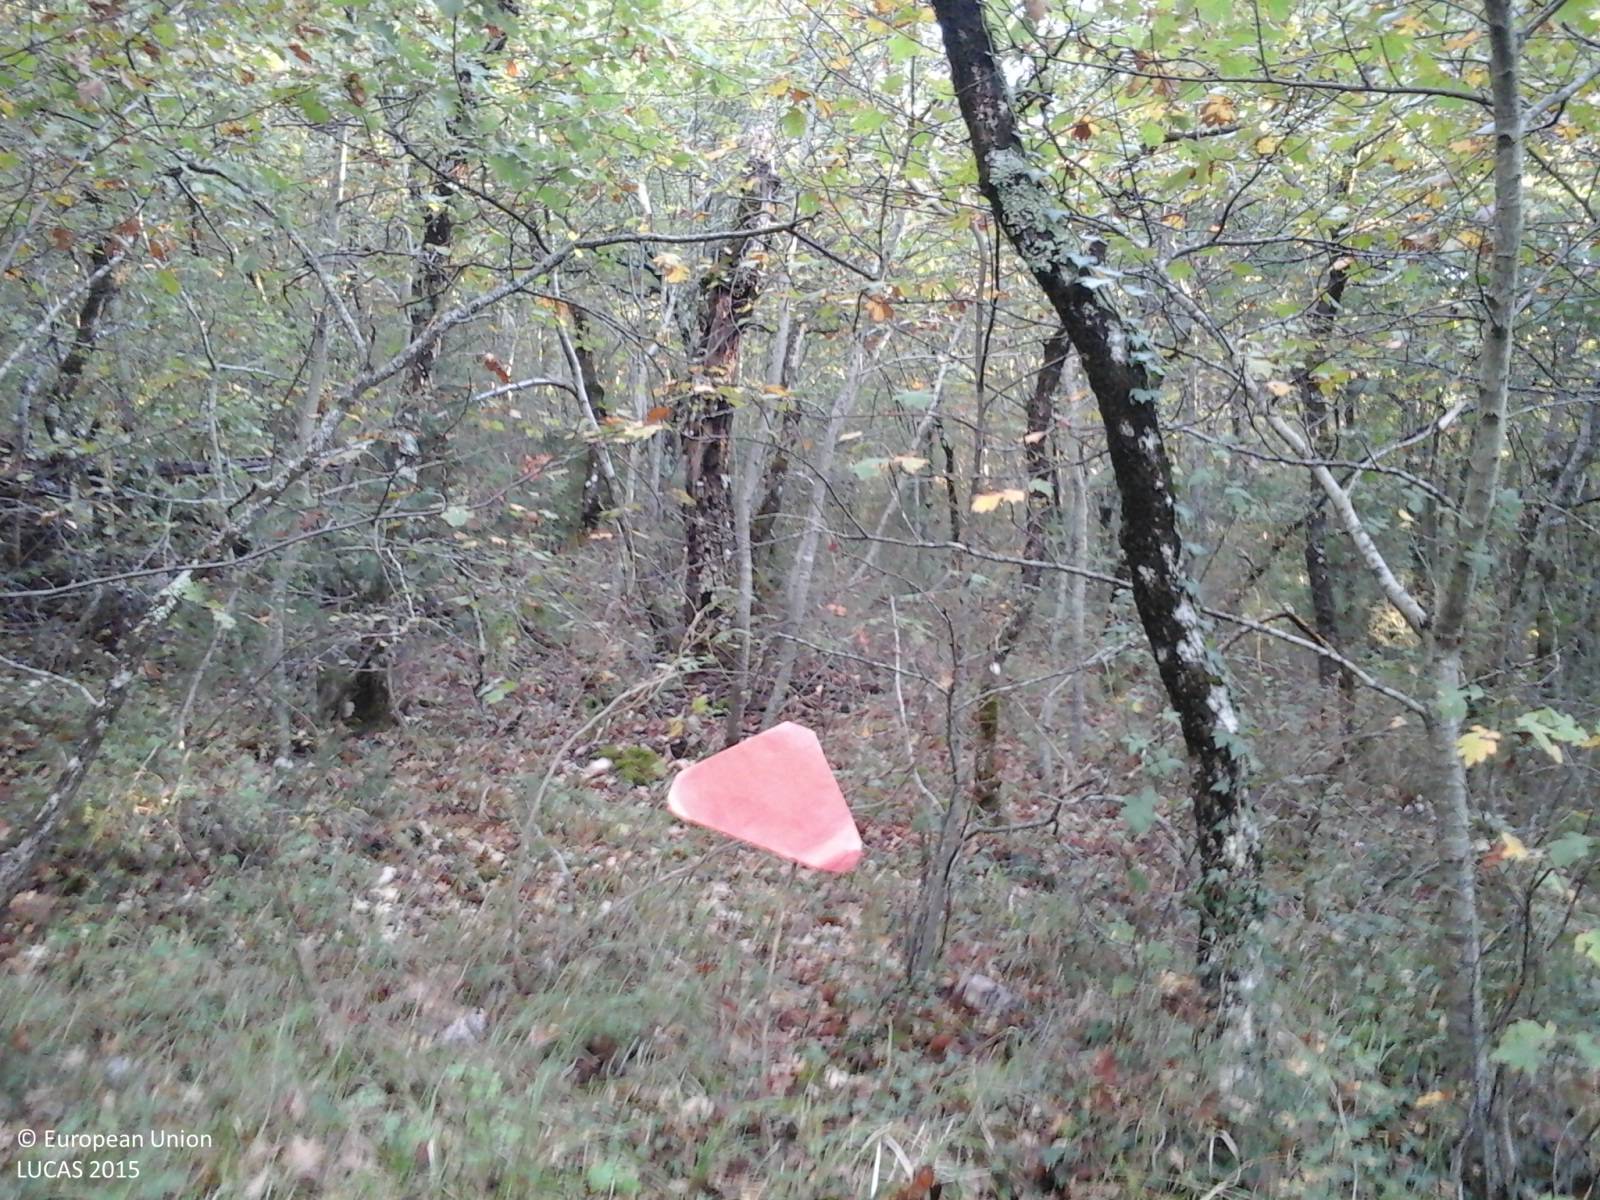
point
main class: Woodland
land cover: Broadleaved woodland
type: thermophilous deciduous forest
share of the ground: > 75 %
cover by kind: broadleaved forest trees 90 %, shrubs 10 %
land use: Forestry
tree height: > 5 m
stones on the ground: 10 - 25 %
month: September
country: IT
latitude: 42.8388
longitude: 12.5493
